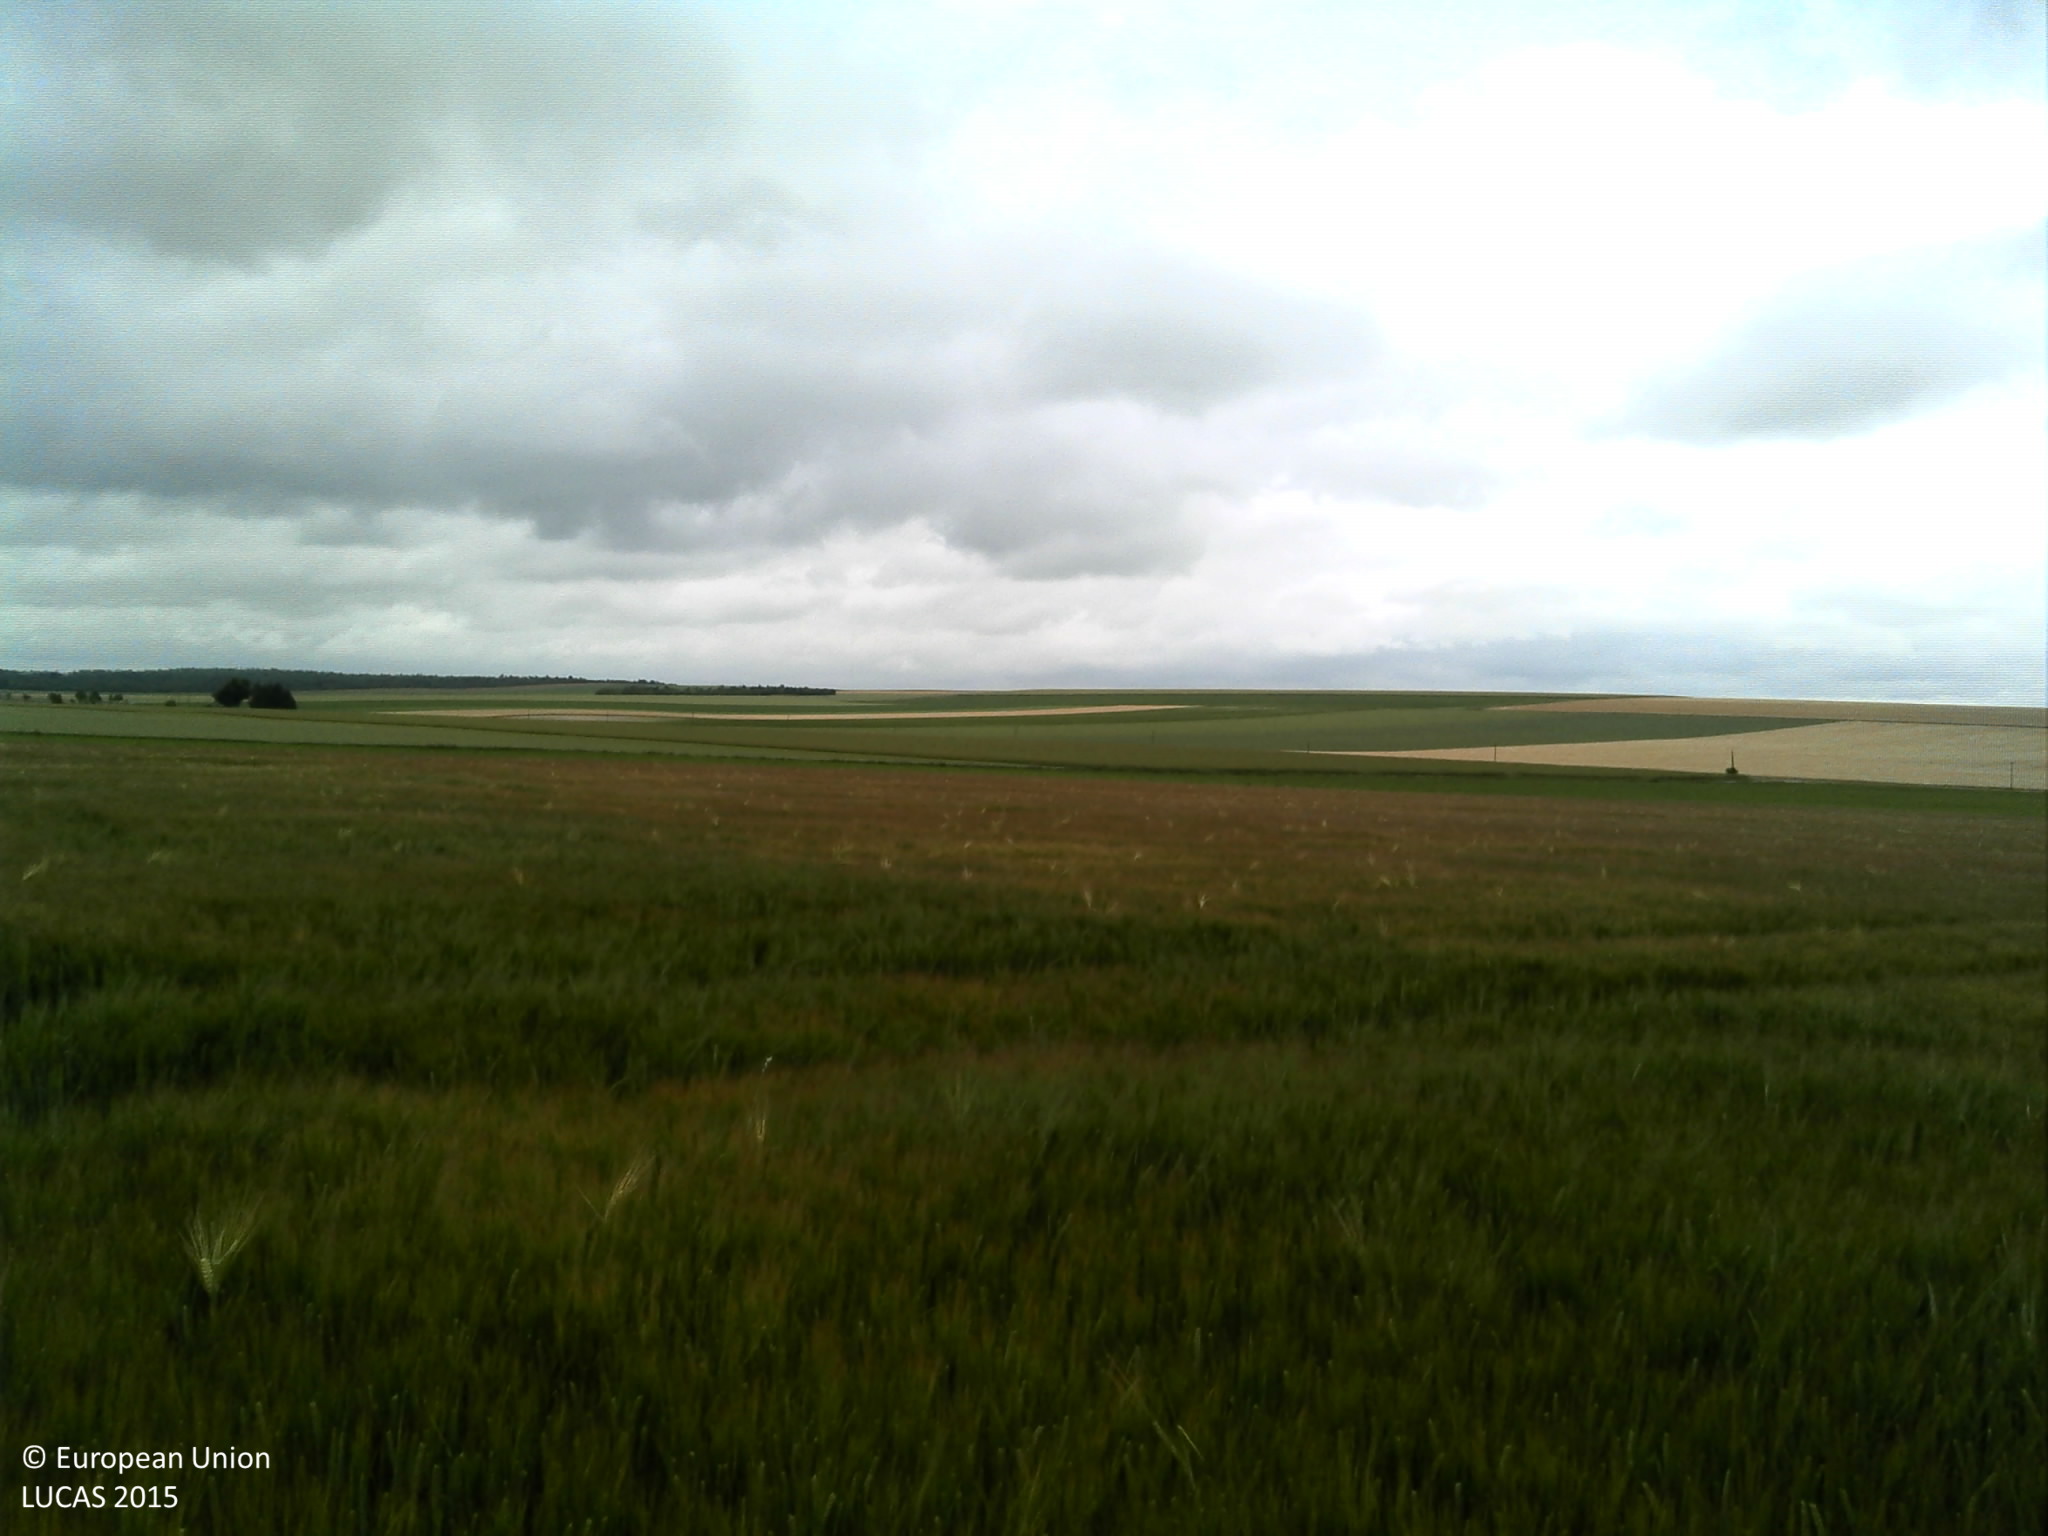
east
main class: Cropland
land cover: Barley
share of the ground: > 75 %
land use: Agriculture (excluding fallow land and kitchen gardens)
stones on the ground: < 10 %
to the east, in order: Barley; Maize
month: June
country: FR
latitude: 48.5792
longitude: 4.2628
